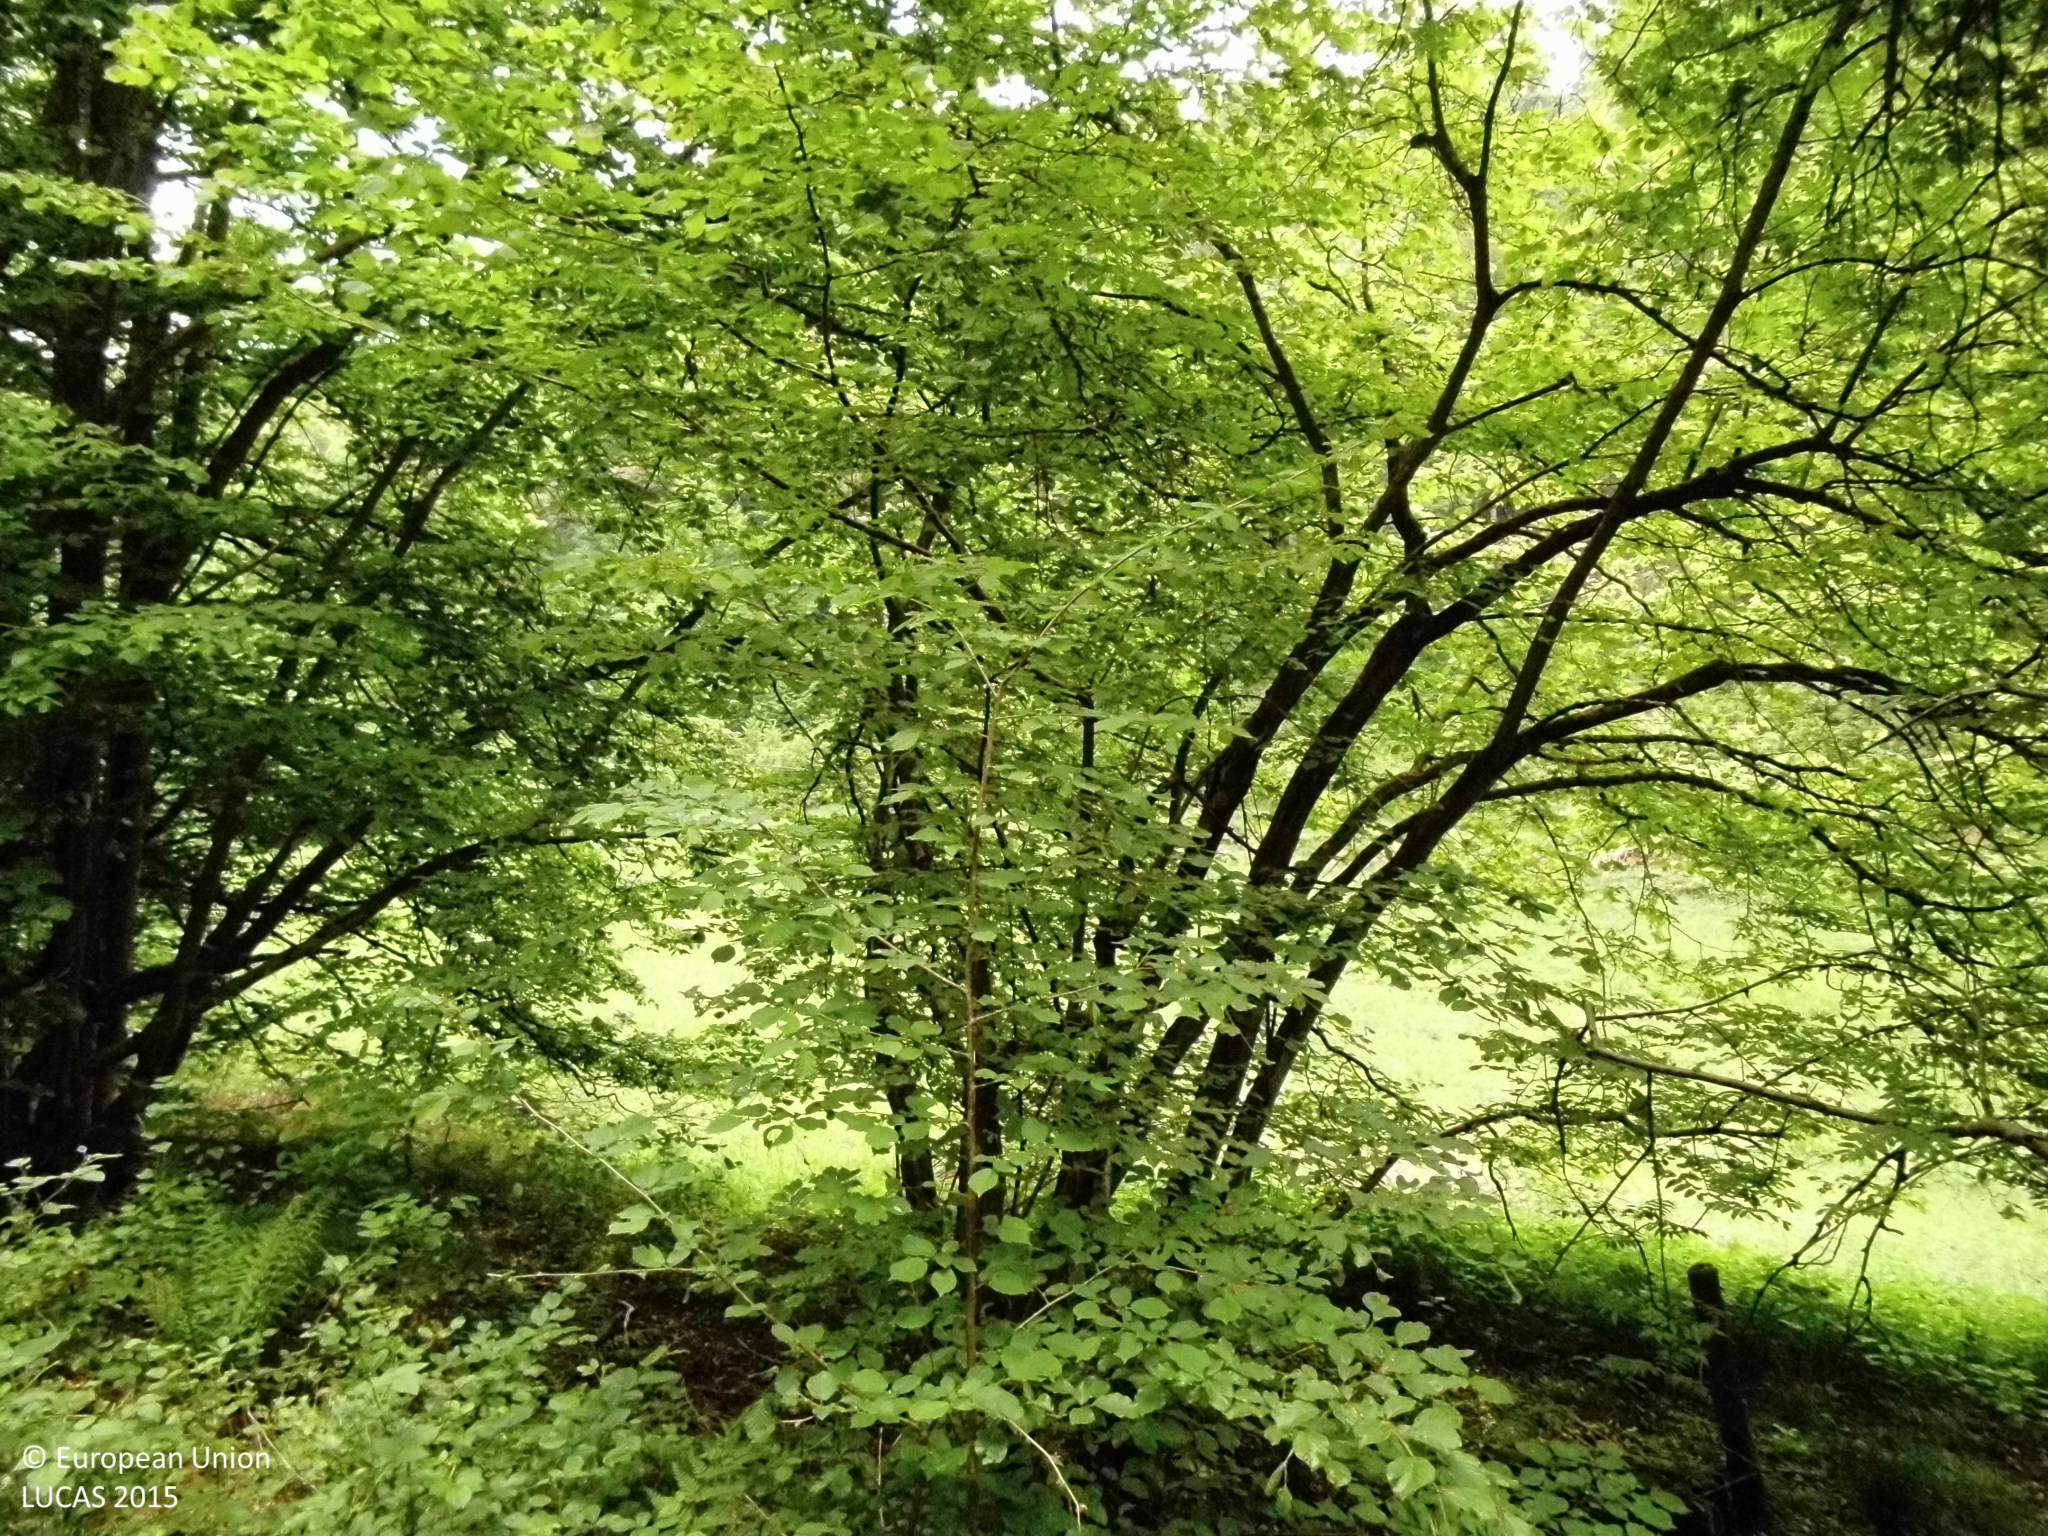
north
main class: Woodland
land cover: Broadleaved woodland
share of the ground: 50 - 75 %
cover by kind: broadleaved forest trees 70 %, shrubs 15 %, herbaceous plants 15 %
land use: Forestry
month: May
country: DE
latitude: 50.5527
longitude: 7.5021
